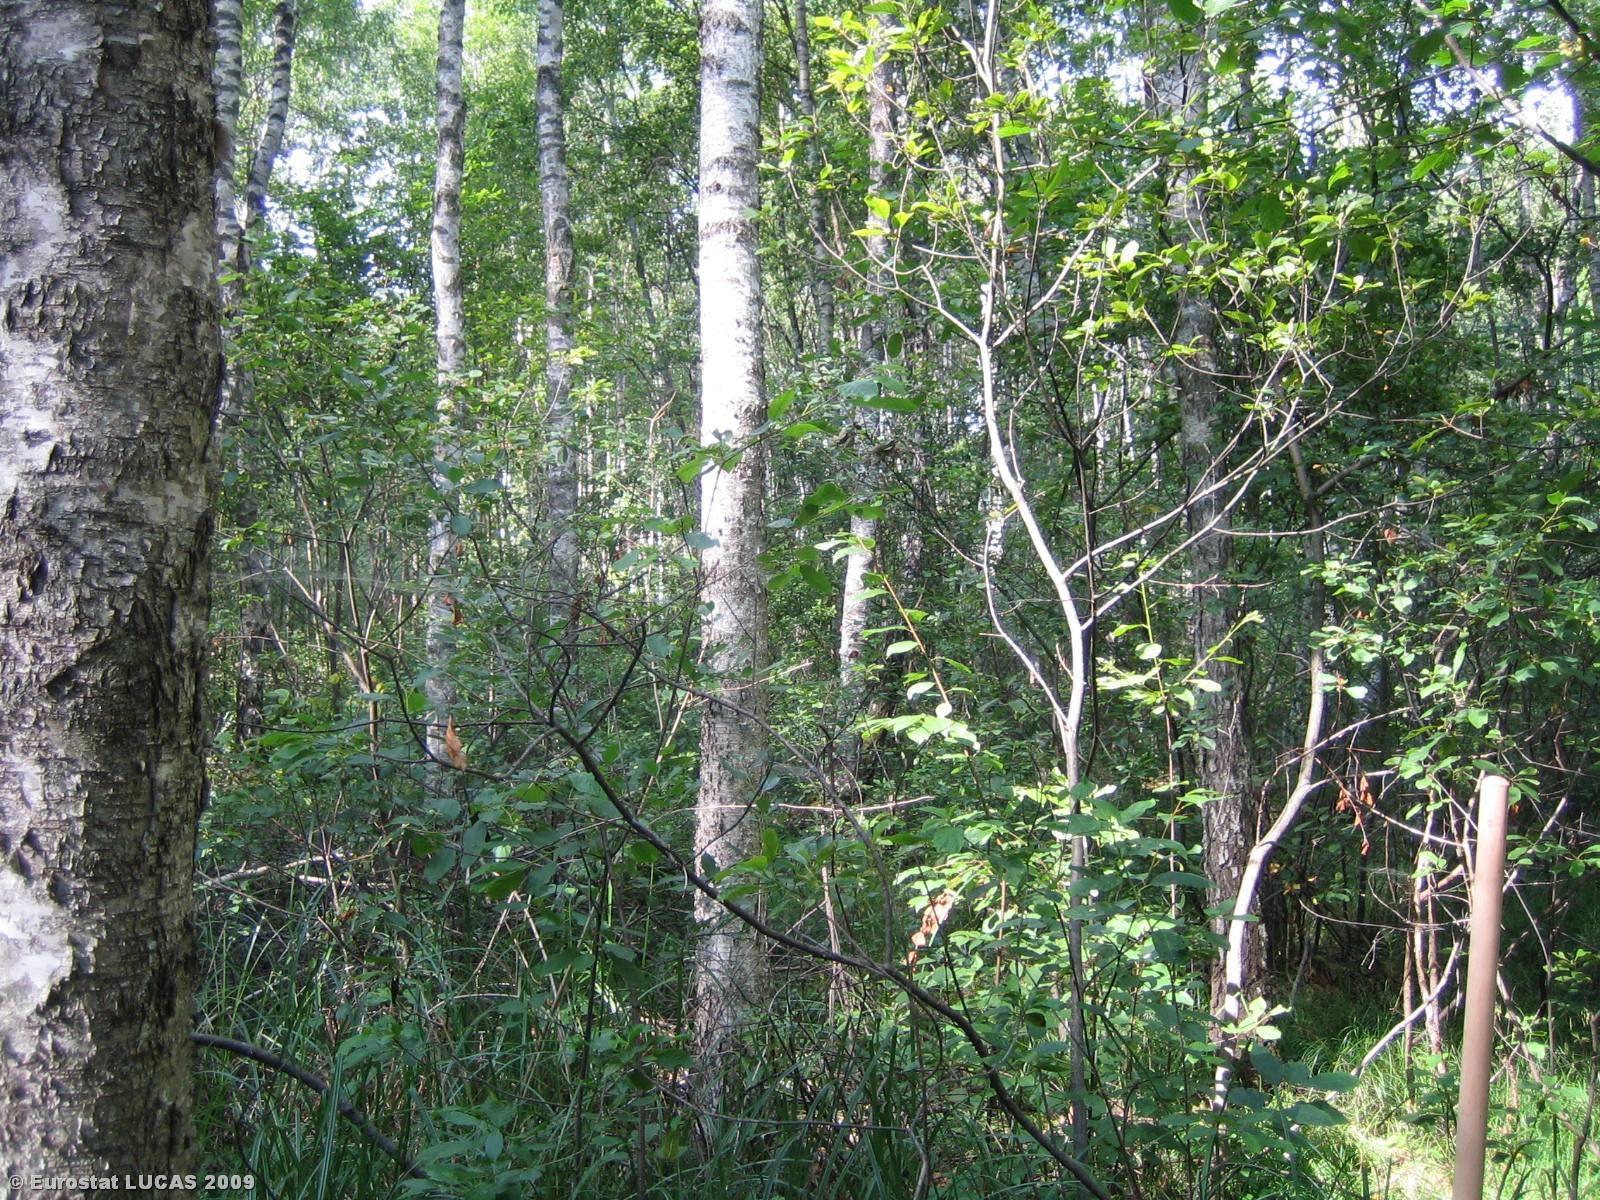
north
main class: Woodland
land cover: Broadleaved woodland
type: hemiboreal forest and nemoral coniferous forest and mixed broadleaved-coniferous forest
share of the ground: > 75 %
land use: Forestry
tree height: > 5 m
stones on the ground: < 10 %
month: July
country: LT
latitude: 55.5670
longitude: 25.6528
